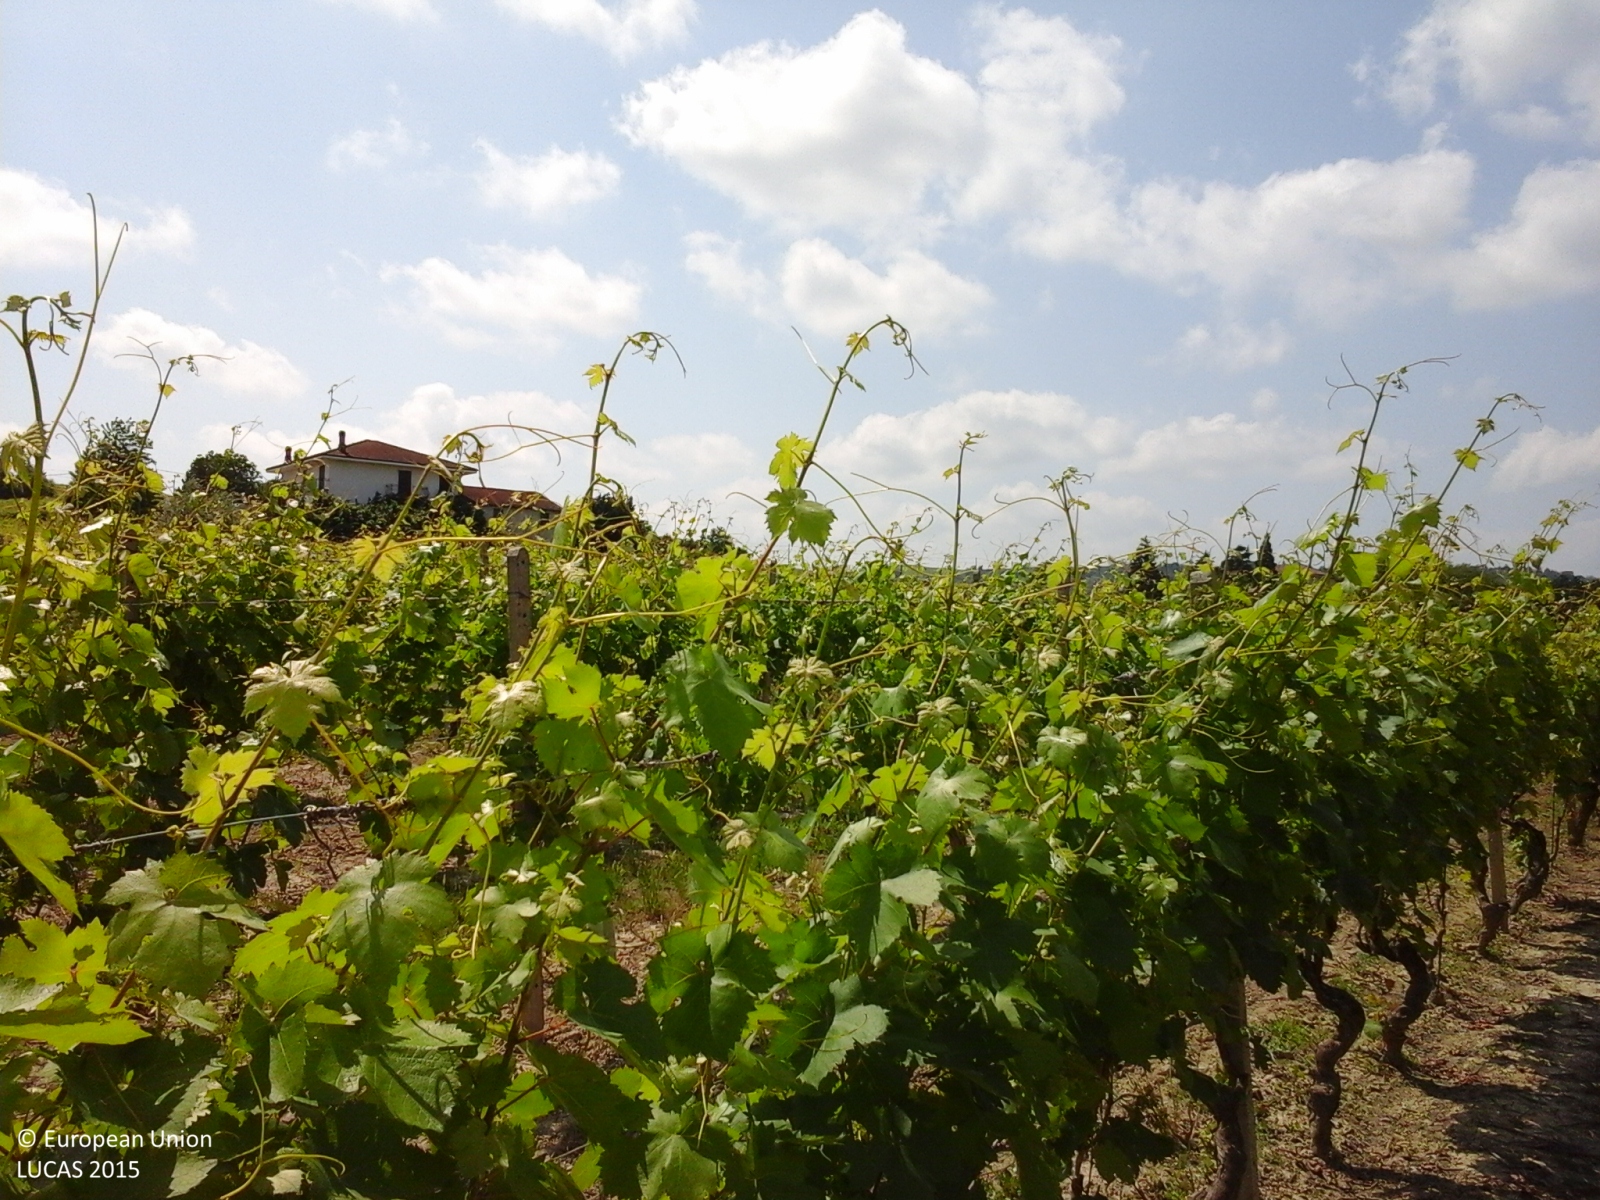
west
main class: Cropland
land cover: Vineyards
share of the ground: 50 - 75 %
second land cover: Grassland without tree/shrub cover
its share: 25 - 50 %
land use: Agriculture (excluding fallow land and kitchen gardens)
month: May
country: IT
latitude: 44.7682
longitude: 8.2220
